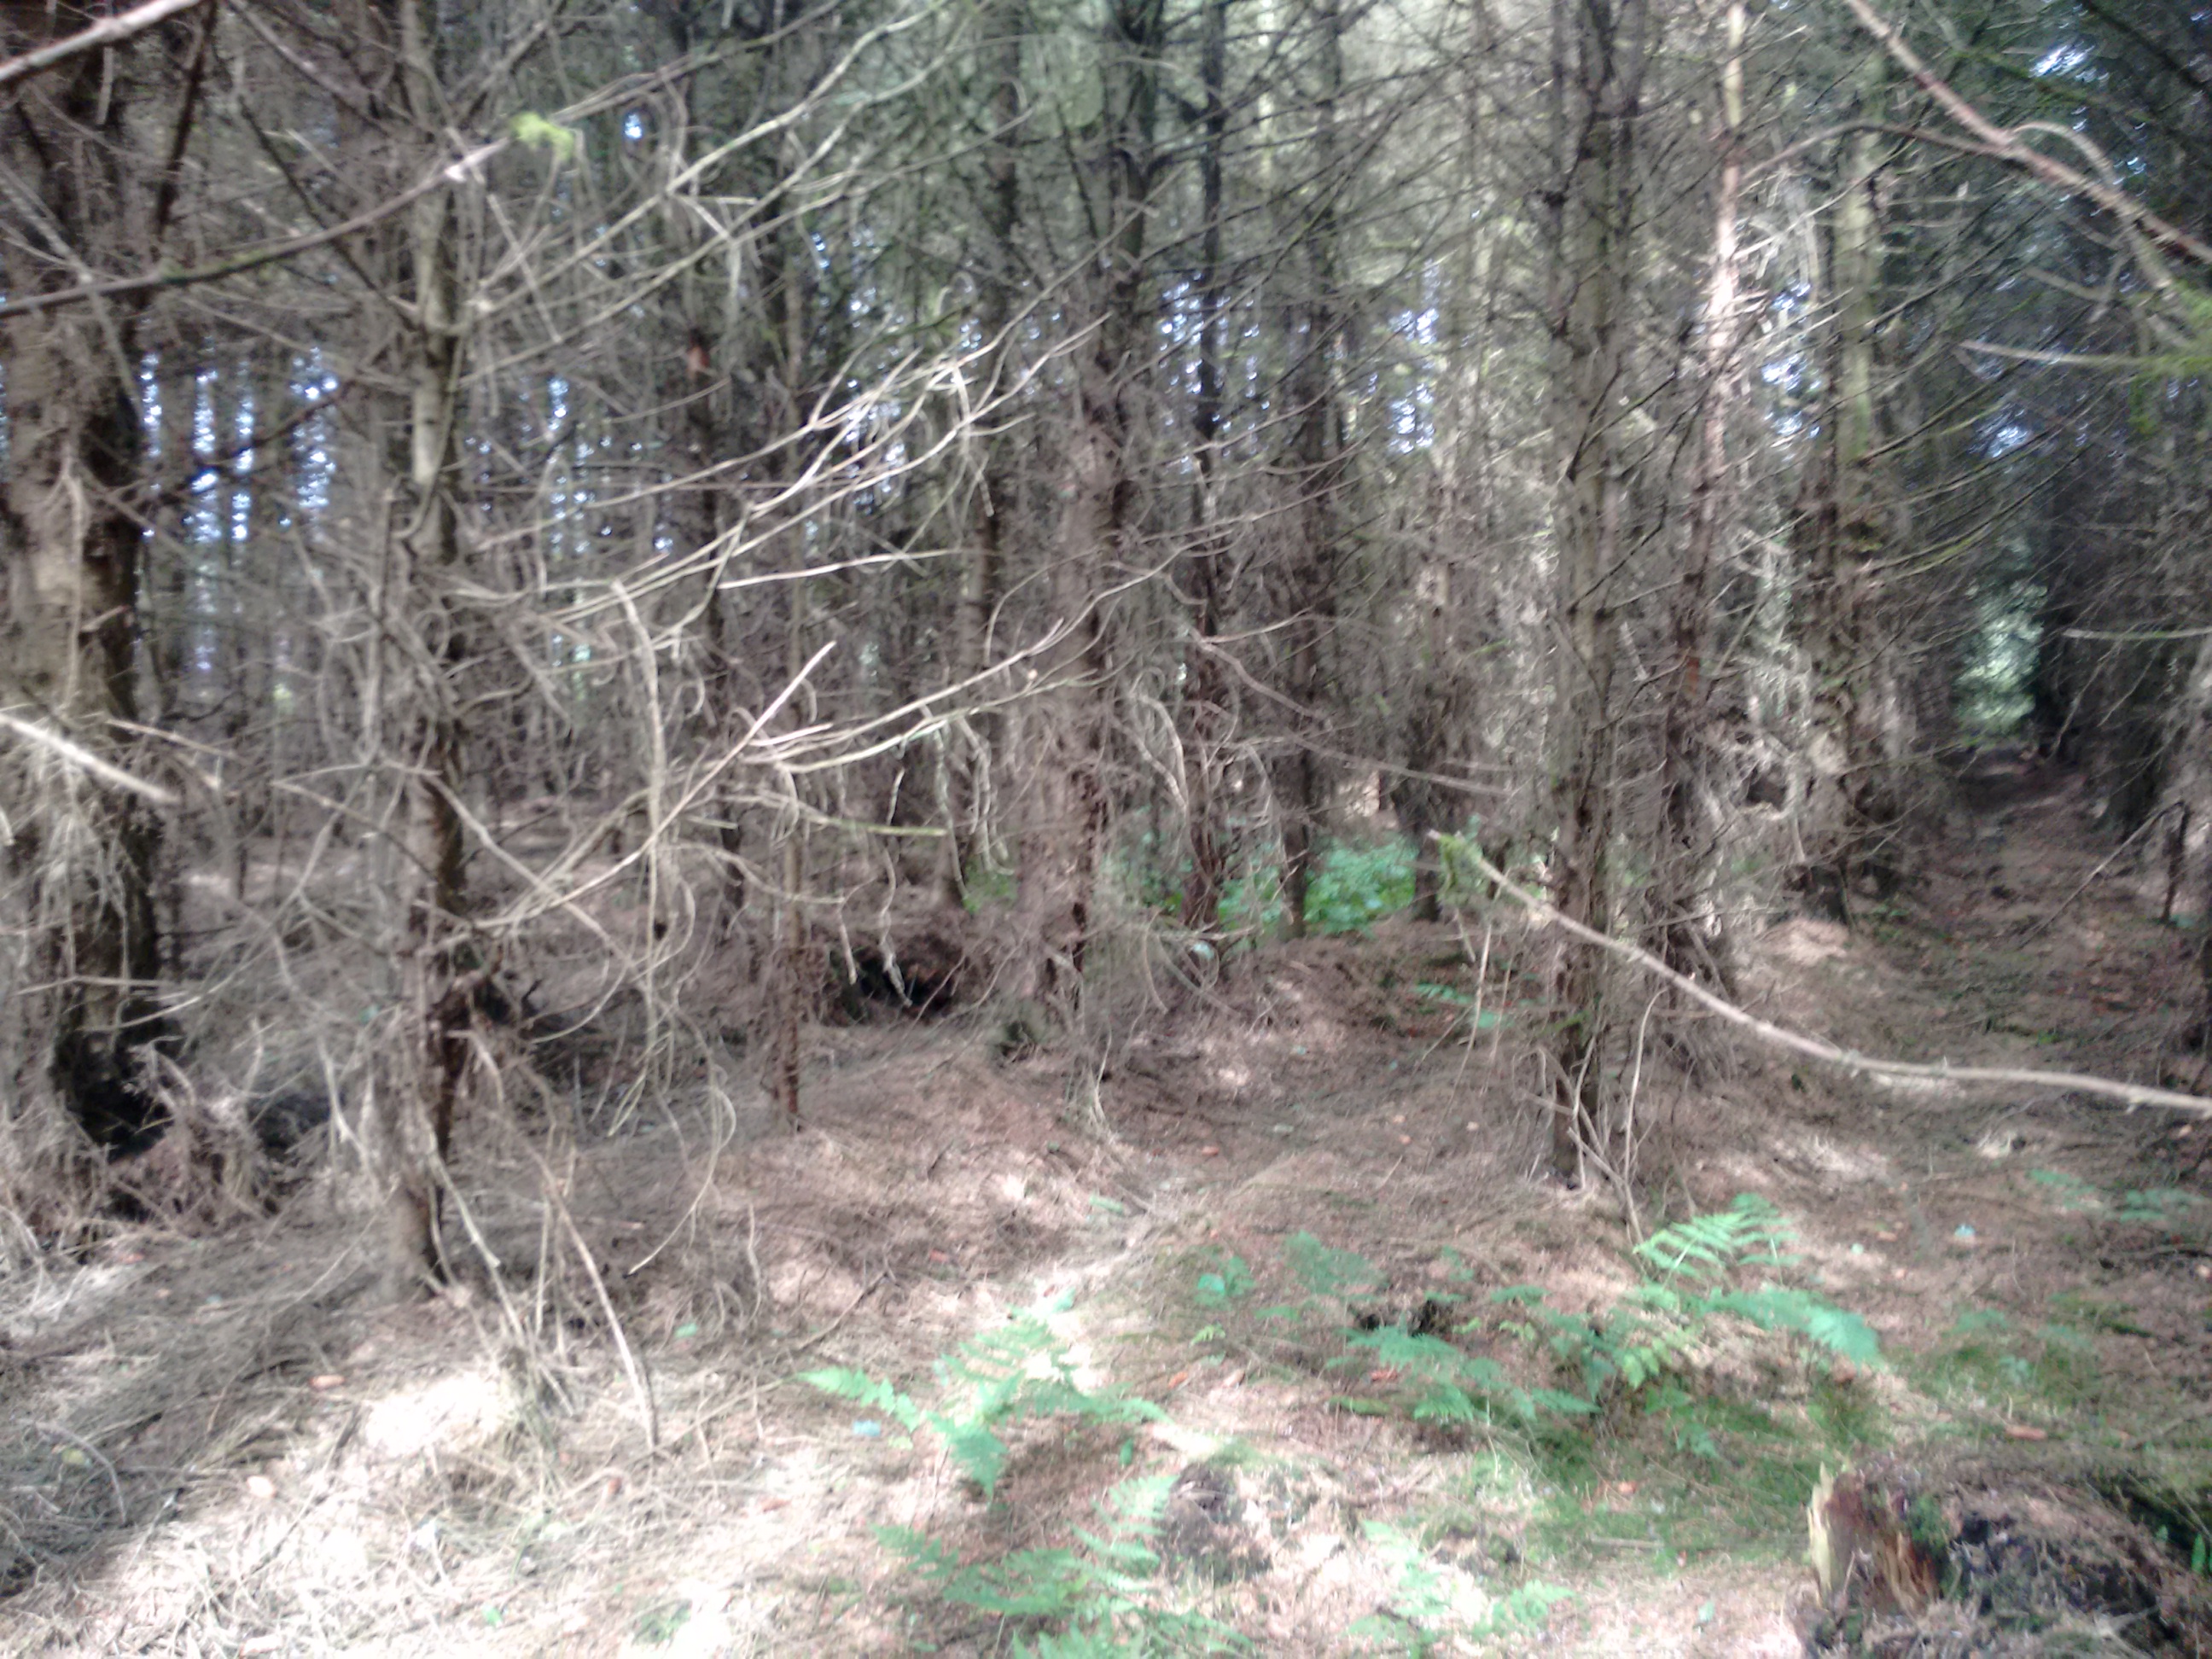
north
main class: Woodland
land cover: Spruce dominated coniferous woodland
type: exotic forest
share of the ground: > 75 %
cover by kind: coniferous forest trees 100 %
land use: Forestry
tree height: > 5 m
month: July
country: GB
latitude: 54.5905
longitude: -7.0559
